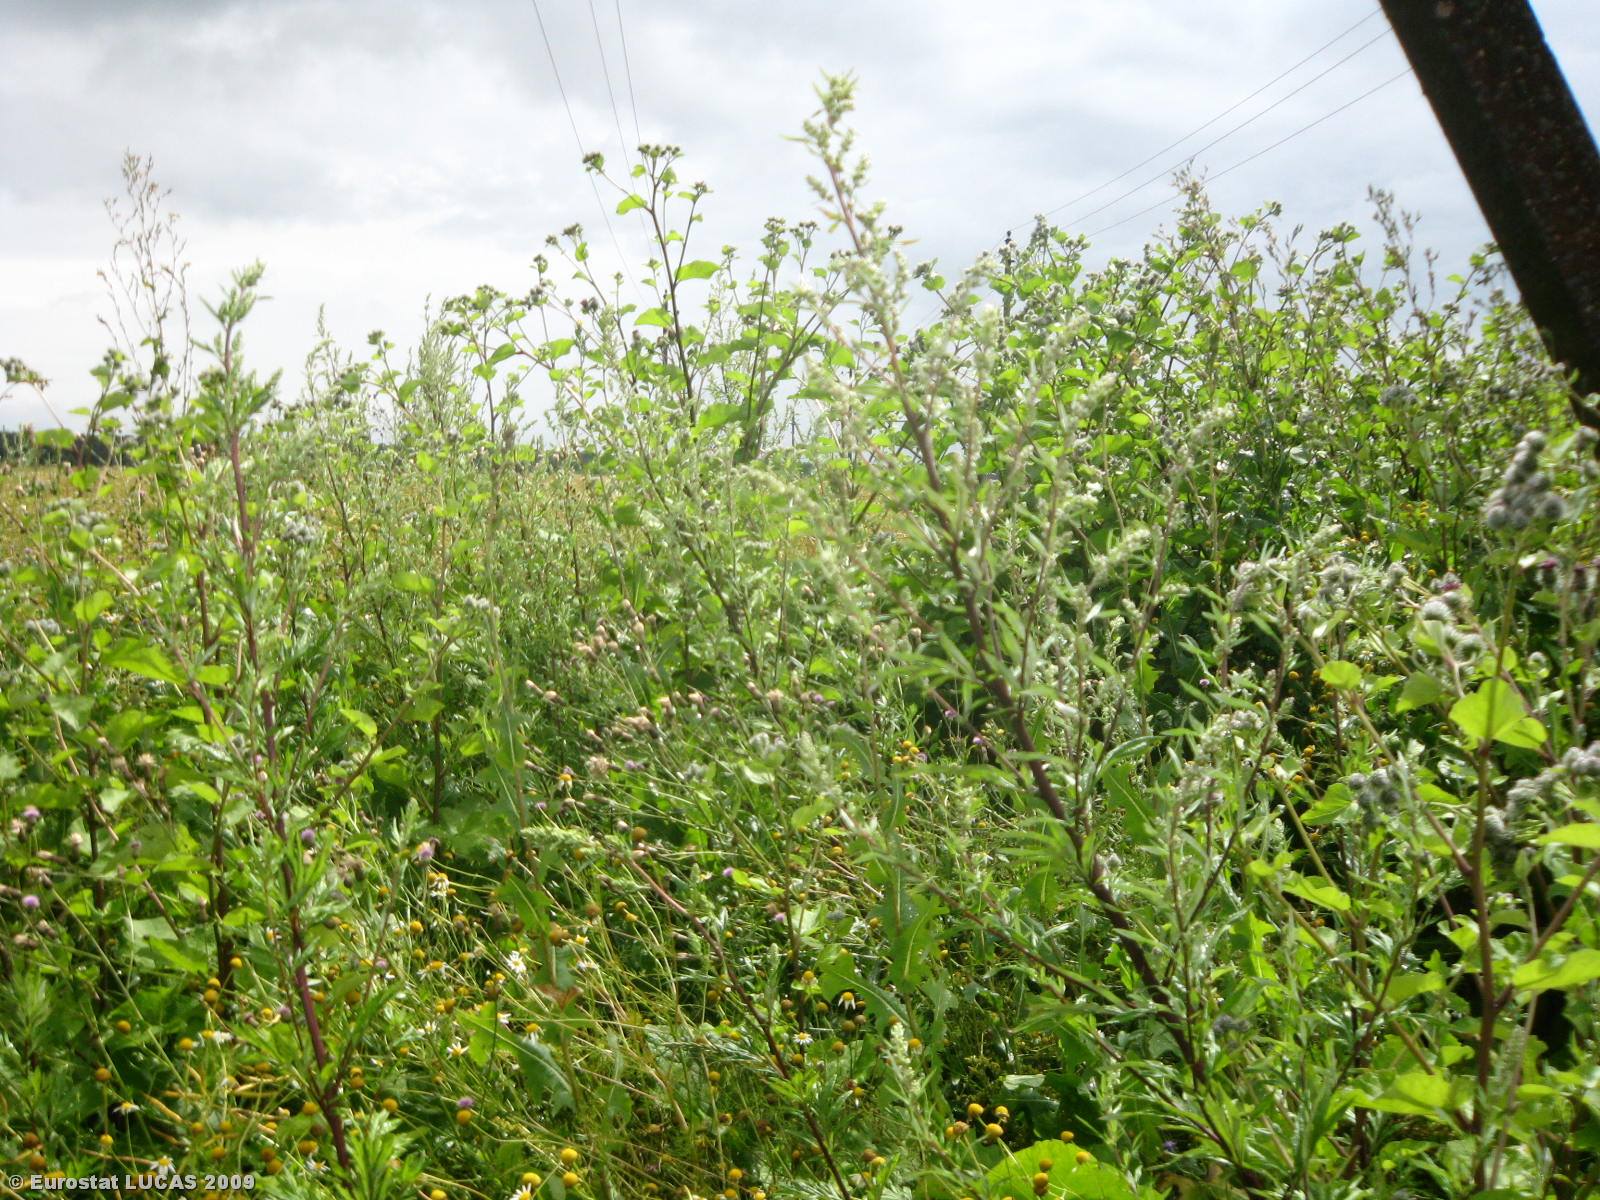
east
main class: Cropland
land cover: Rape and turnip rape
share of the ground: > 75 %
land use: Agriculture (excluding fallow land and kitchen gardens)
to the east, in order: Rape and turnip rape; Electric lines; Grassland without tree/shrub cover; Rape and turnip rape; Electric lines; Rape and turnip rape; Grass margins; Paved roads, cycling and walking lanes; Grassland without tree/shrub cover
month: July
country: LT
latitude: 55.5088
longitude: 23.8135
